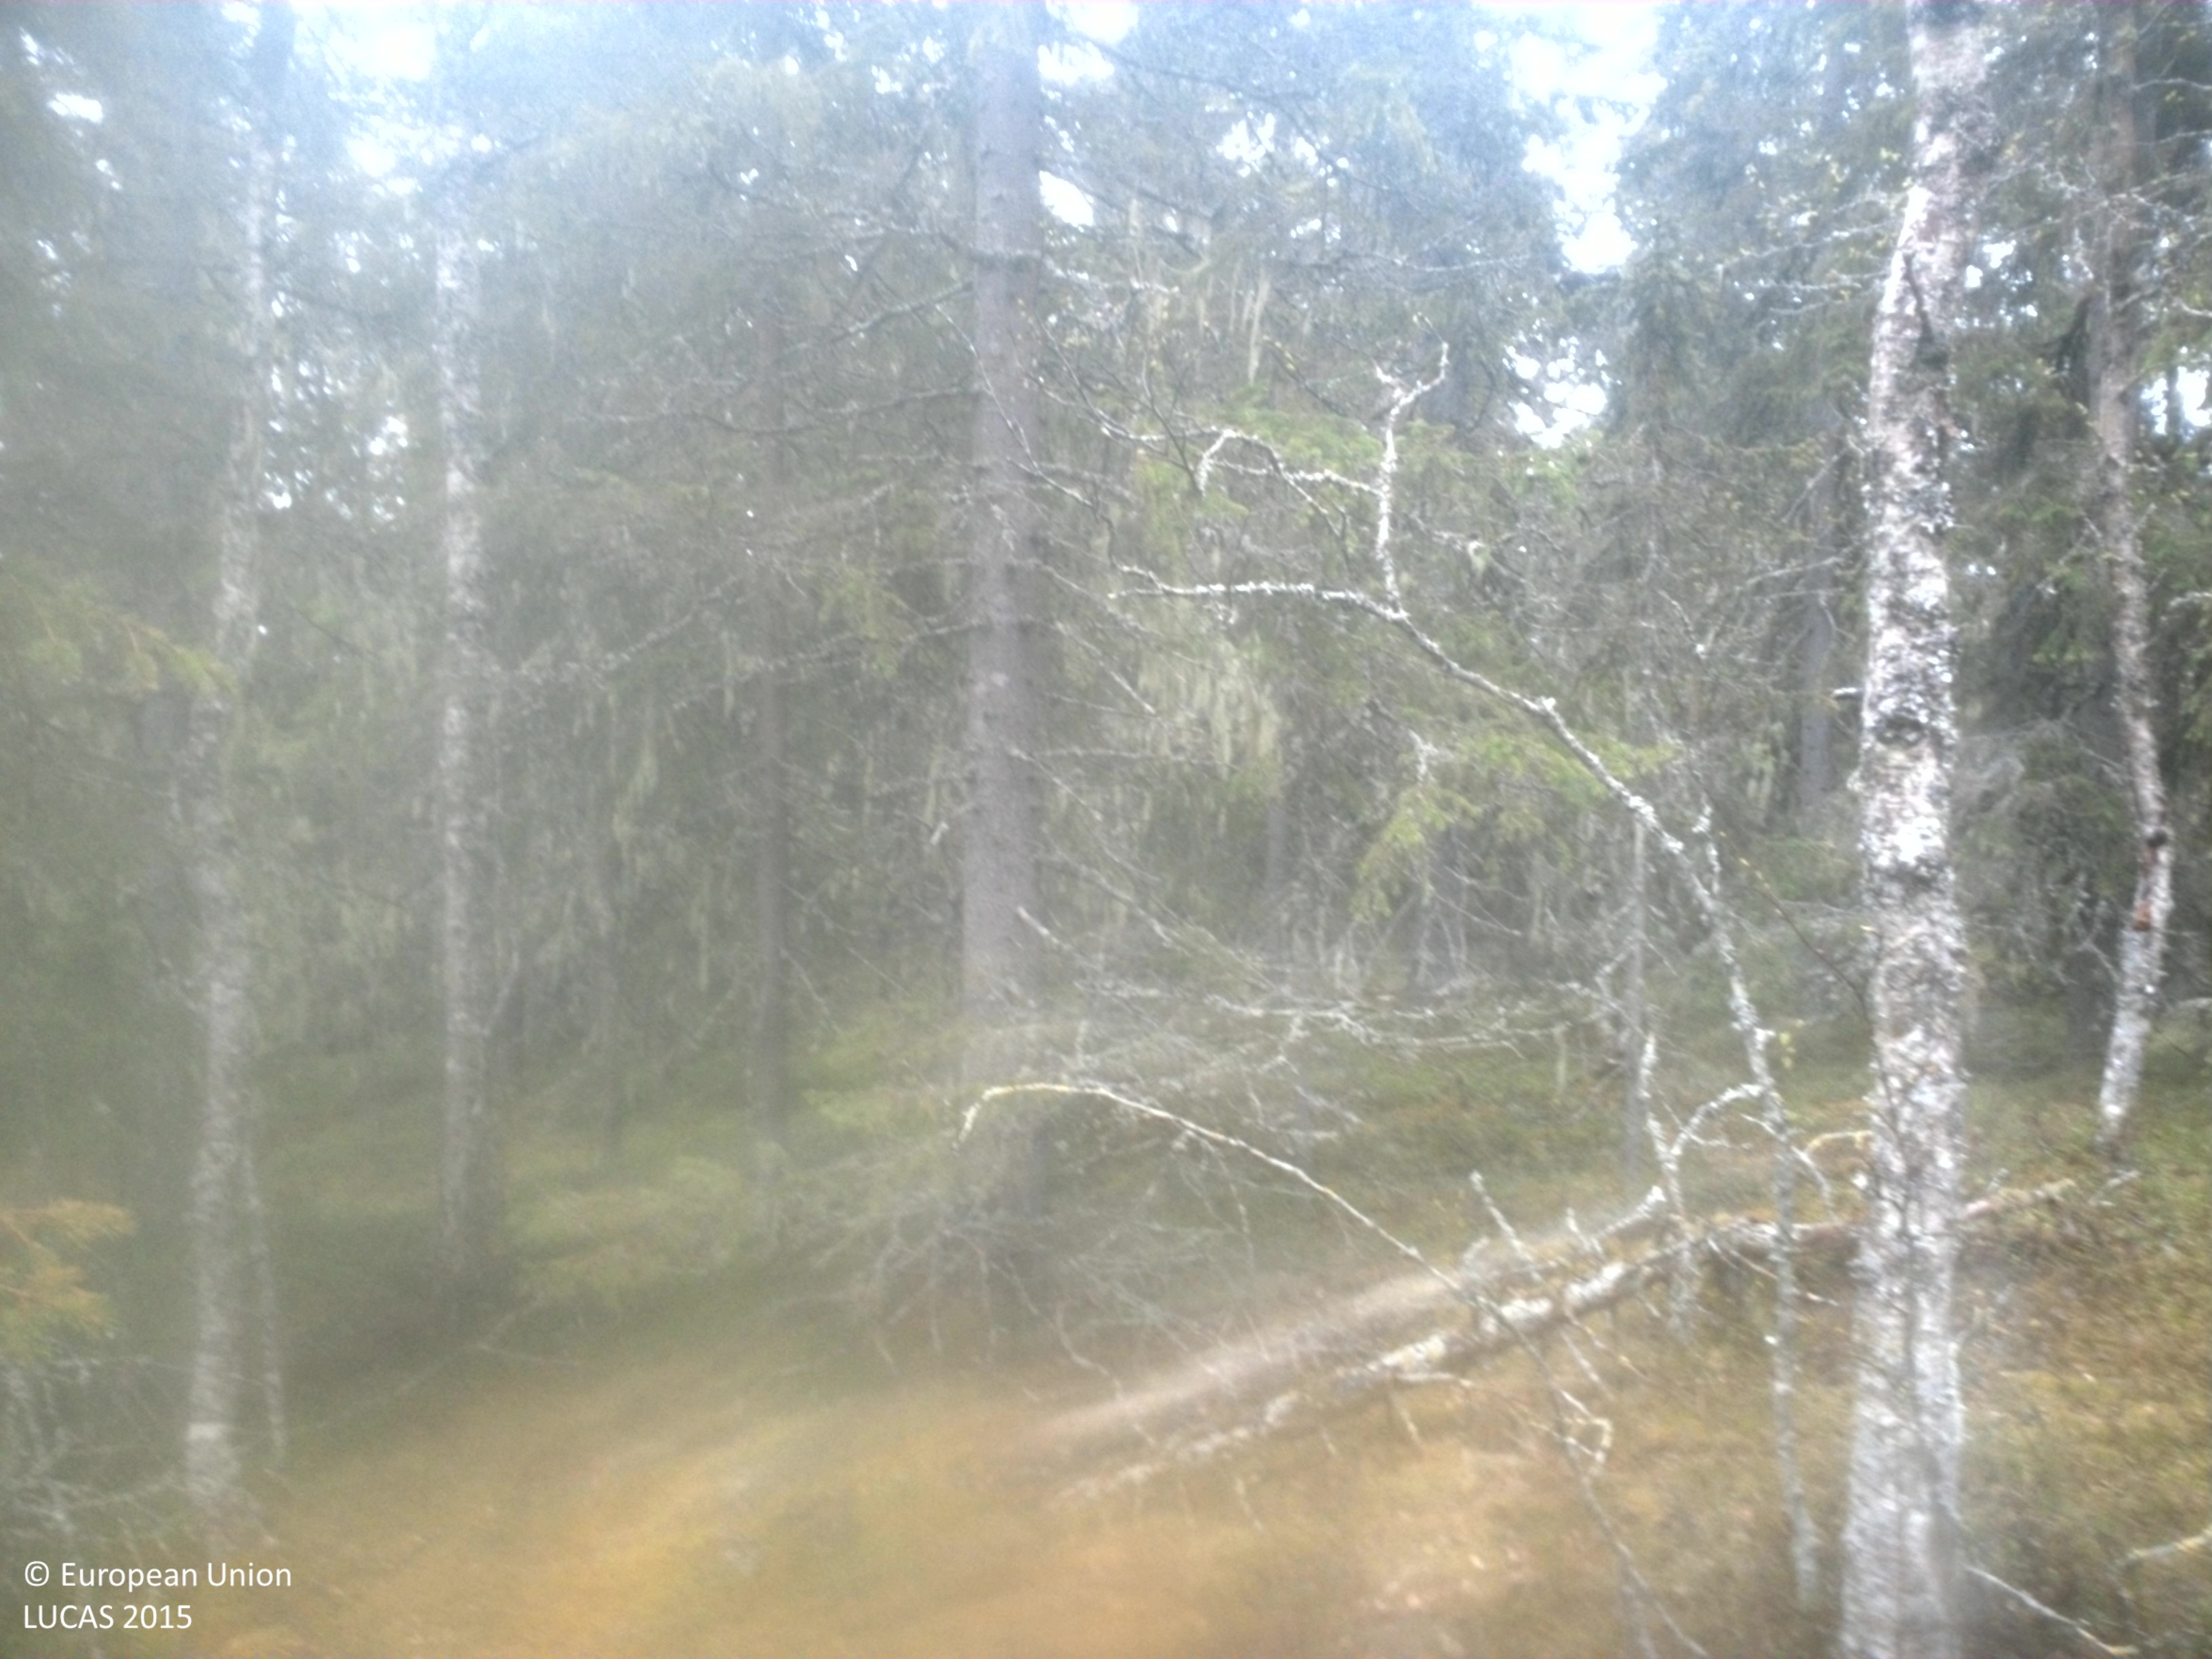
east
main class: Woodland
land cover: Spruce dominated coniferous woodland
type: boreal forest
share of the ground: 50 - 75 %
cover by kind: coniferous forest trees 50 %, herbaceous plants 20 %, lichens and mosses 15 %, broadleaved forest trees 10 %, shrubs 5 %
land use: Forestry
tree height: > 5 m
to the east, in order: Spruce dominated coniferous woodland; Ditches and canals; Spruce dominated coniferous woodland; Grassland without tree/shrub cover; Abandoned hedges; Ditches and canals; Abandoned hedges; Grassland without tree/shrub cover; Single bushes/trees; Grassland without tree/shrub cover; Abandoned hedges; Ditches and canals; Abandoned hedges; Grassland with sparse tree/shrub cover; Abandoned hedges; Ditches and canals; Abandoned hedges; Grassland with sparse tree/shrub cover; Abandoned hedges; Ditches and canals; Abandoned hedges; Spontaneously vegetated surfaces; Abandoned hedges; Ditches and canals; Abandoned hedges; Spruce dominated coniferous woodland; Ditches and canals; Abandoned hedges; Grassland without tree/shrub cover
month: June
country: SE
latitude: 64.3722
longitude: 18.1123
